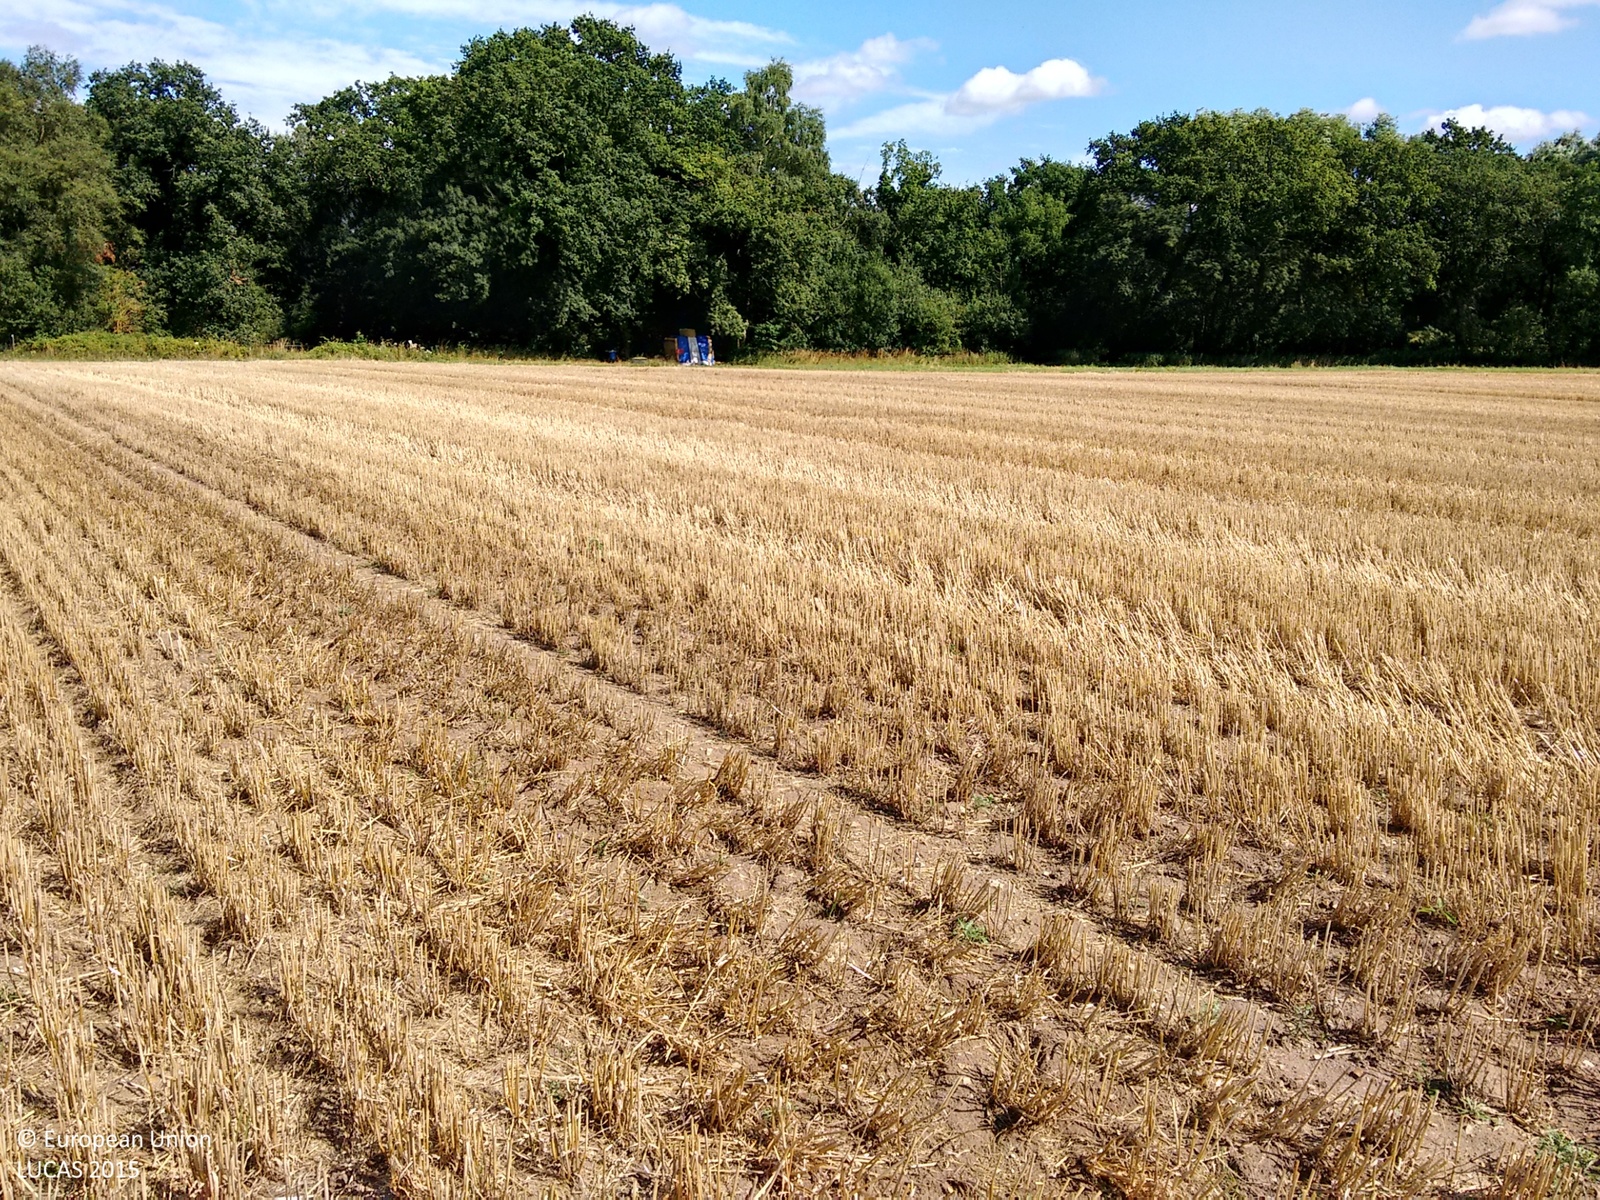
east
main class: Cropland
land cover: Common wheat
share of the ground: > 75 %
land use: Agriculture (excluding fallow land and kitchen gardens)
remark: Harvested field
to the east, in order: Common wheat; Grassland without tree/shrub cover; Broadleaved woodland; Fences; Broadleaved woodland; Fences; Tracks; Grassland without tree/shrub cover; Fences; Grass margins; Ditches and canals; Grass margins; Fences; Grassland without tree/shrub cover; Abandoned hedges; Grassland without tree/shrub cover
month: August
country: GB
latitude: 52.7261
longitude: 0.8099
